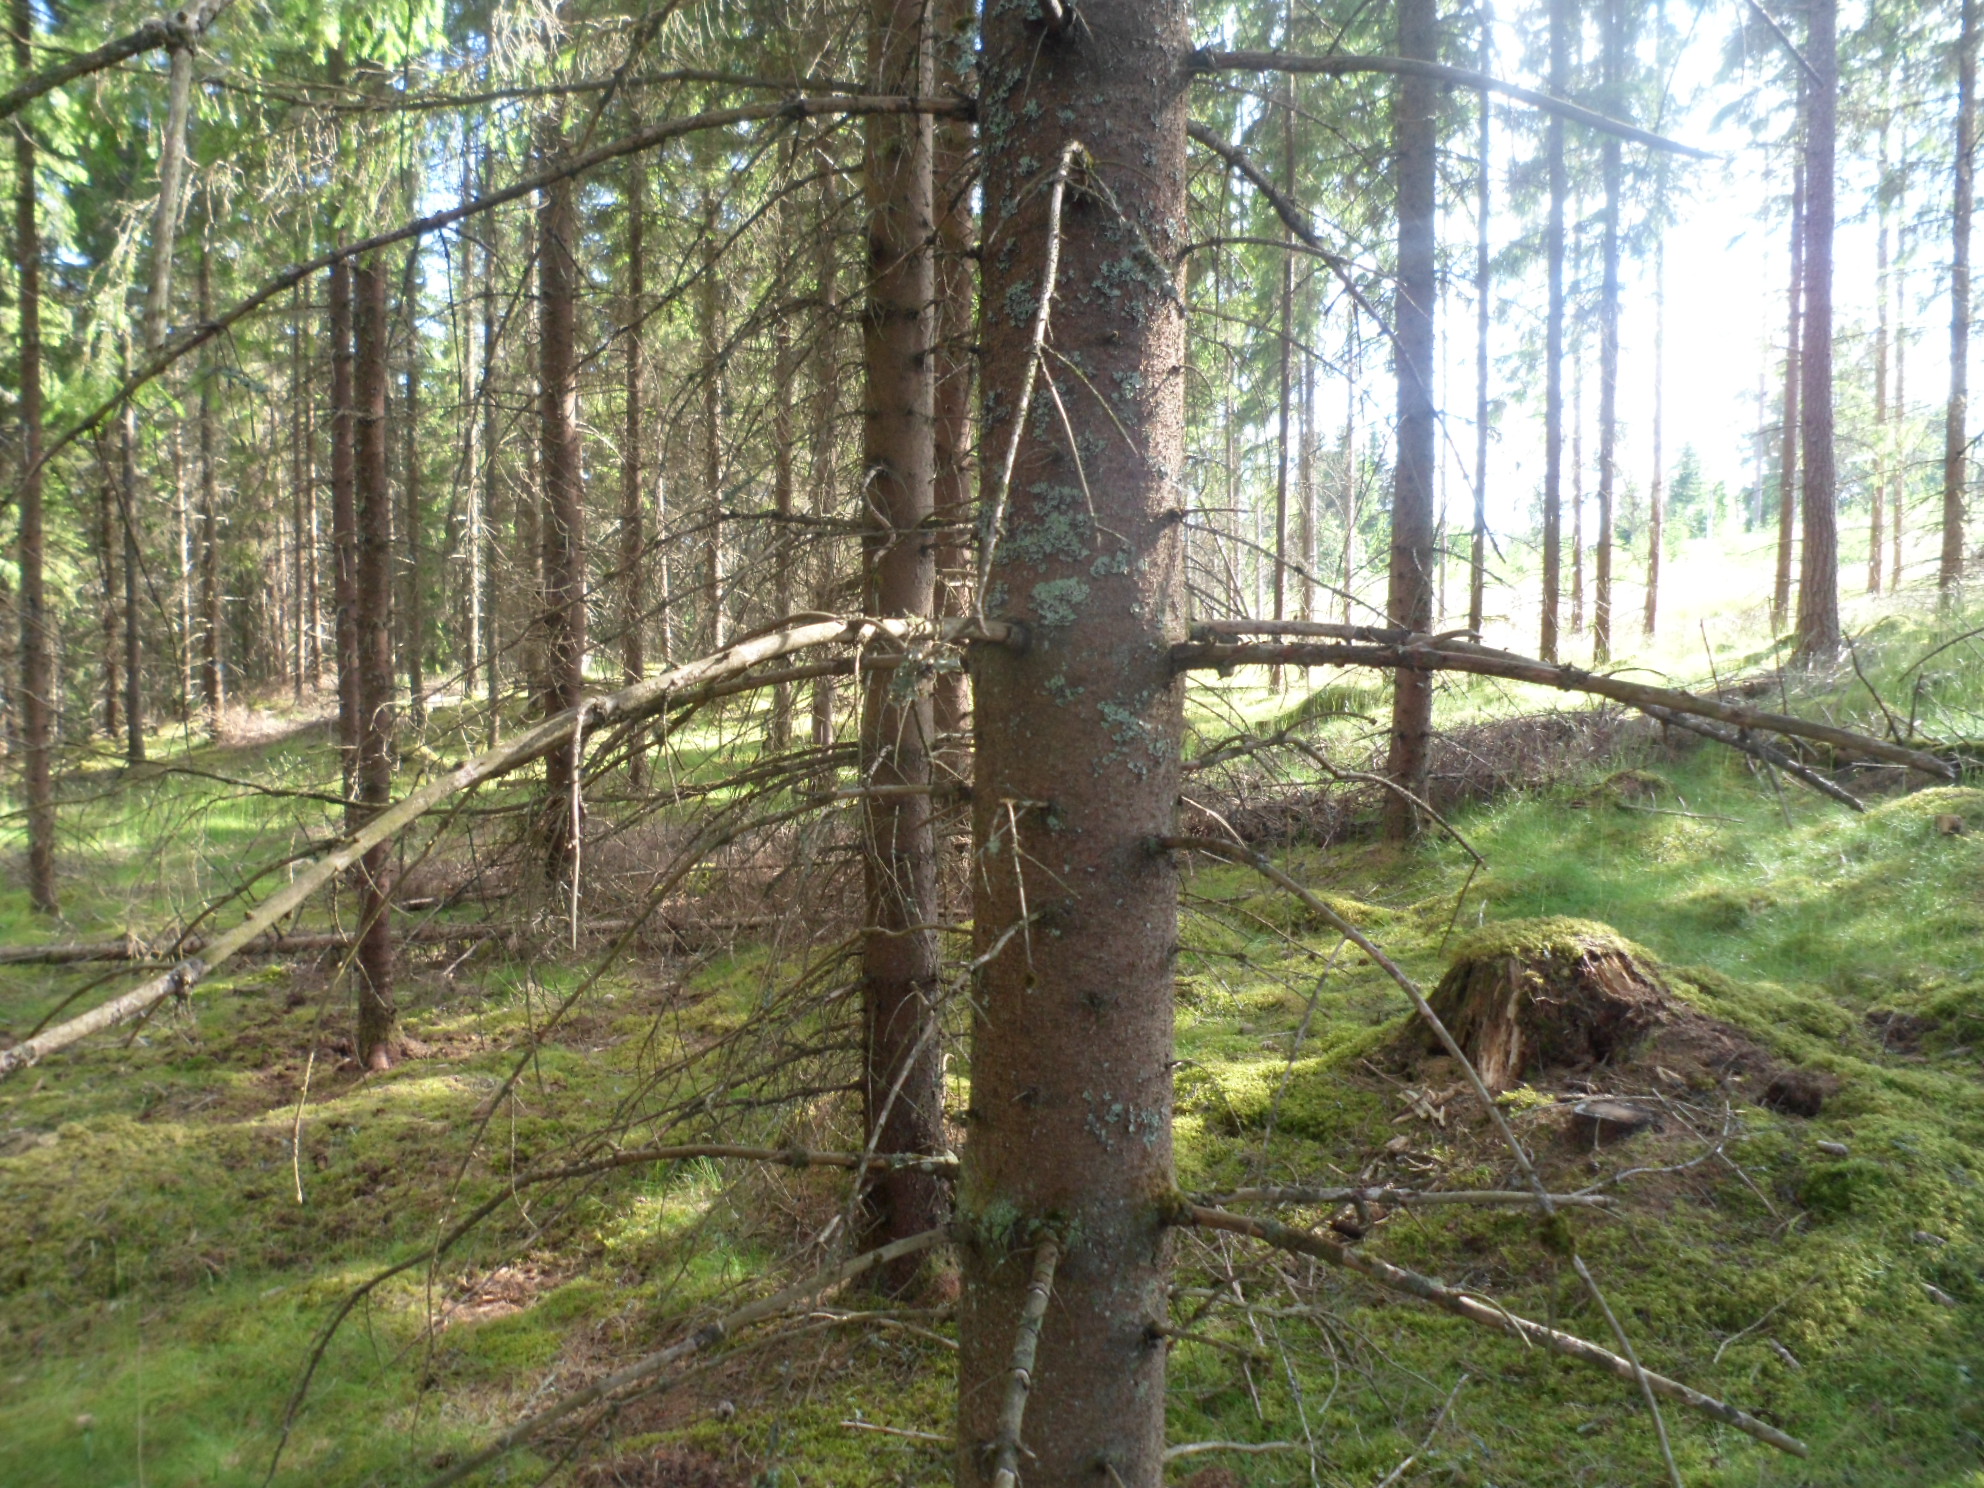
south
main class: Woodland
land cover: Spruce dominated coniferous woodland
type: boreal forest
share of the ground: 50 - 75 %
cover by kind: coniferous forest trees 60 %, lichens and mosses 25 %, herbaceous plants 15 %
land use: Forestry
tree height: > 5 m
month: July
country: SE
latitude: 57.5545
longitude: 14.3574
